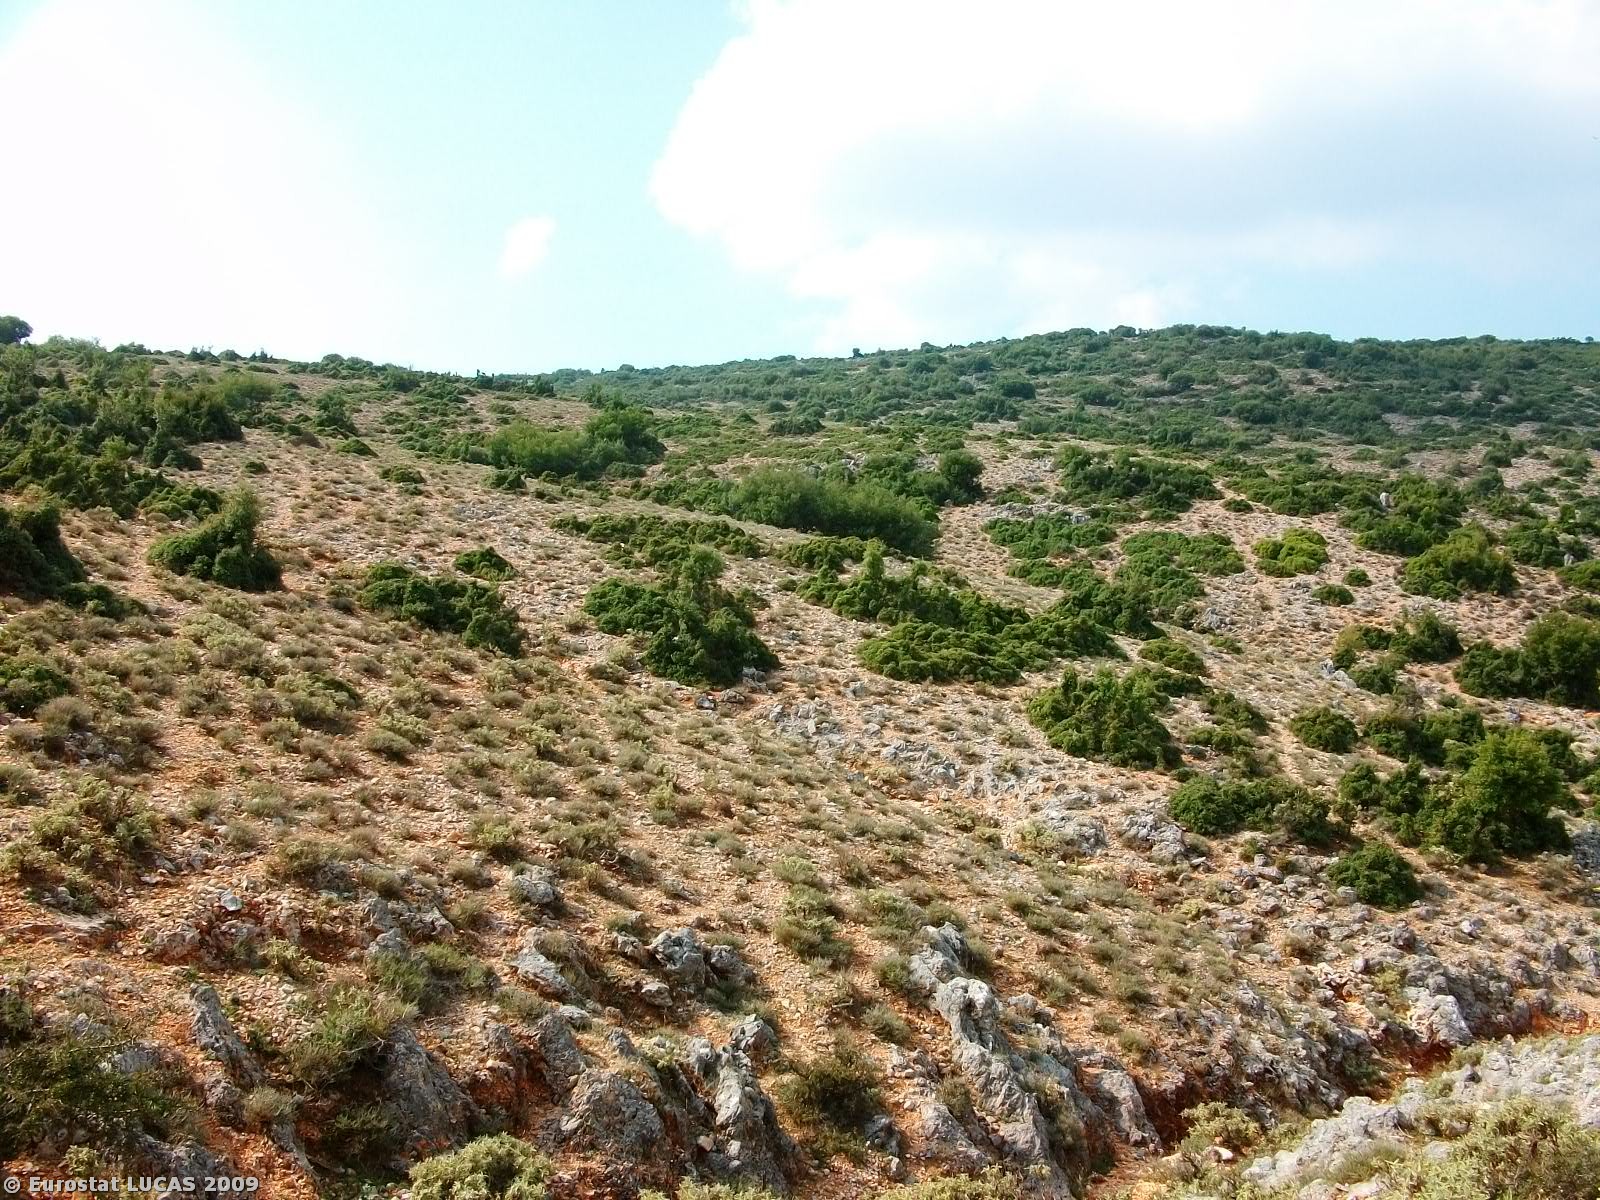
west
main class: Grassland
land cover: Grassland with sparse tree/shrub cover
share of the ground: 25 - 50 %
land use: Agriculture (excluding fallow land and kitchen gardens)
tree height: < 5 m
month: October
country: GR
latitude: 39.4196
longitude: 20.4161
